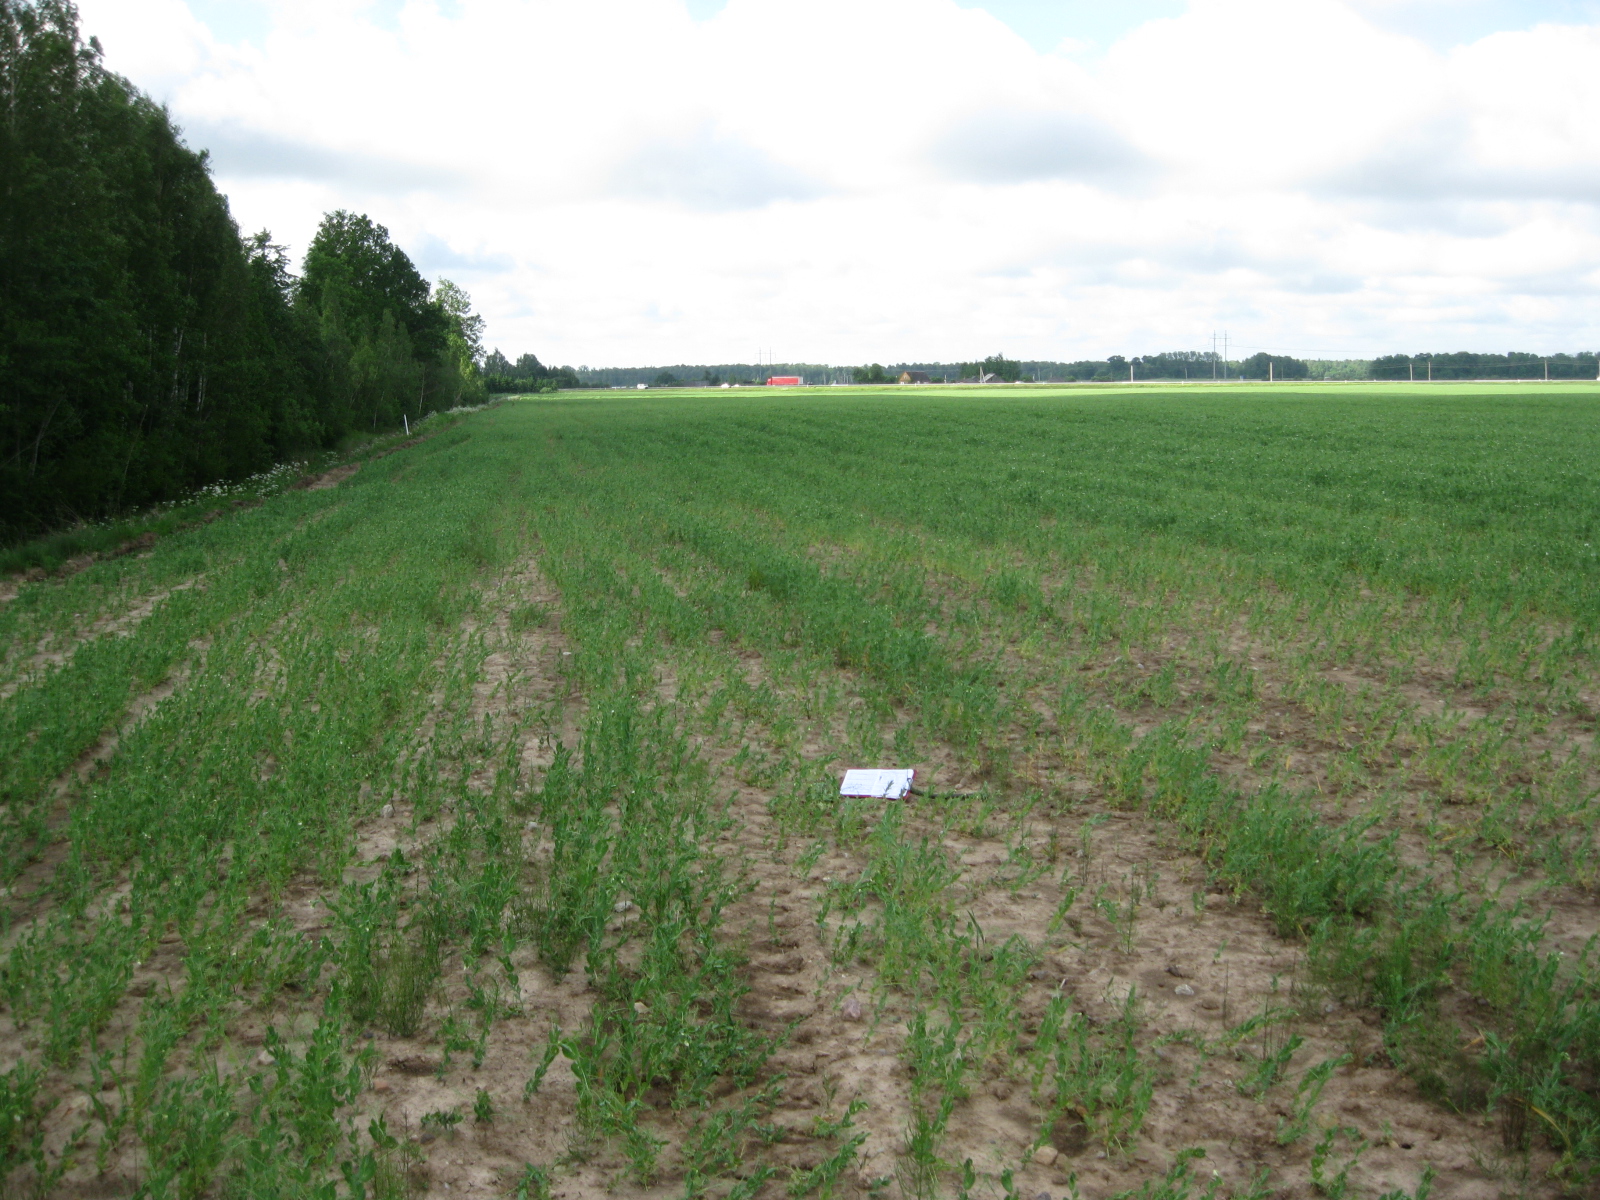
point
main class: Cropland
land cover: Dry pulses
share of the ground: 25 - 50 %
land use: Agriculture (excluding fallow land and kitchen gardens)
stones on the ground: < 10 %
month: June
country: LT
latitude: 55.1780
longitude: 23.6662
